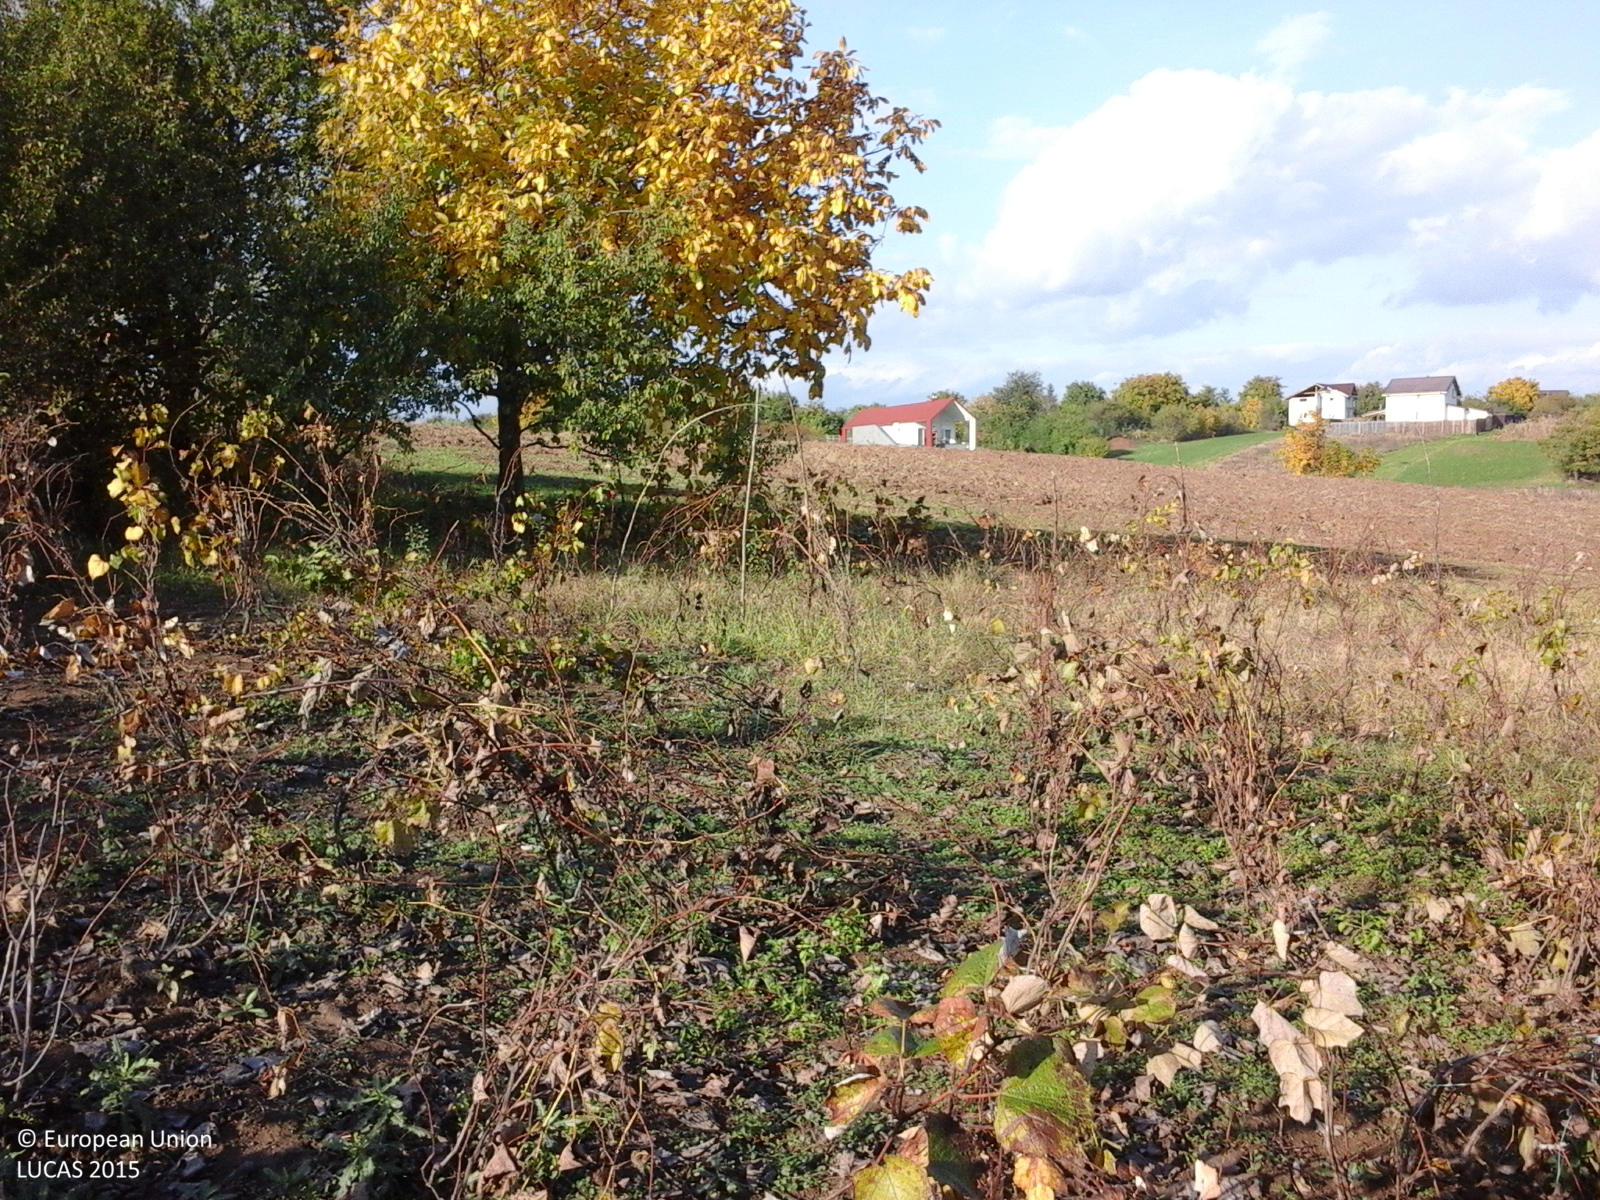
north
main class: Cropland
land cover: Vineyards
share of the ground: > 75 %
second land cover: Grassland without tree/shrub cover
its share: > 75 %
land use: Agriculture (excluding fallow land and kitchen gardens)
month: October
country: RO
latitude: 44.6761
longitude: 26.0129
